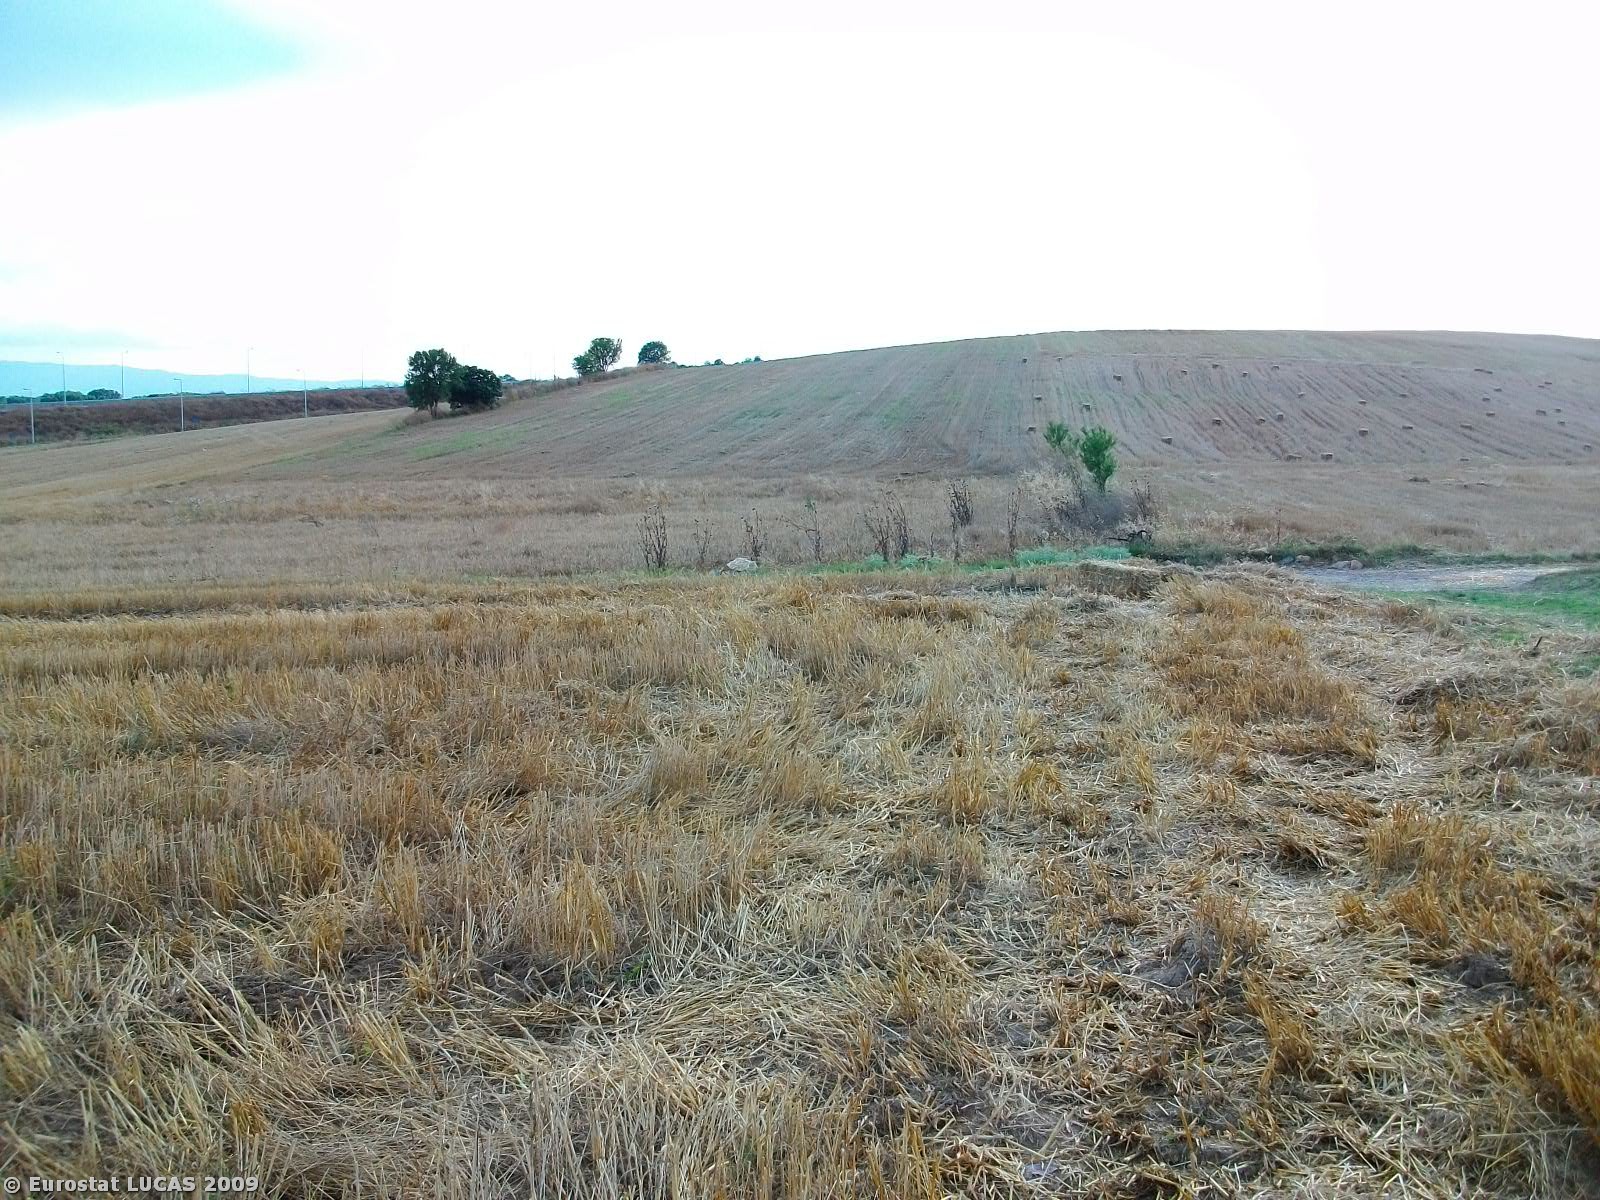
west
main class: Cropland
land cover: Durum wheat
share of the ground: > 75 %
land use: Agriculture (excluding fallow land and kitchen gardens)
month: June
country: GR
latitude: 41.0555
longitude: 23.5965
